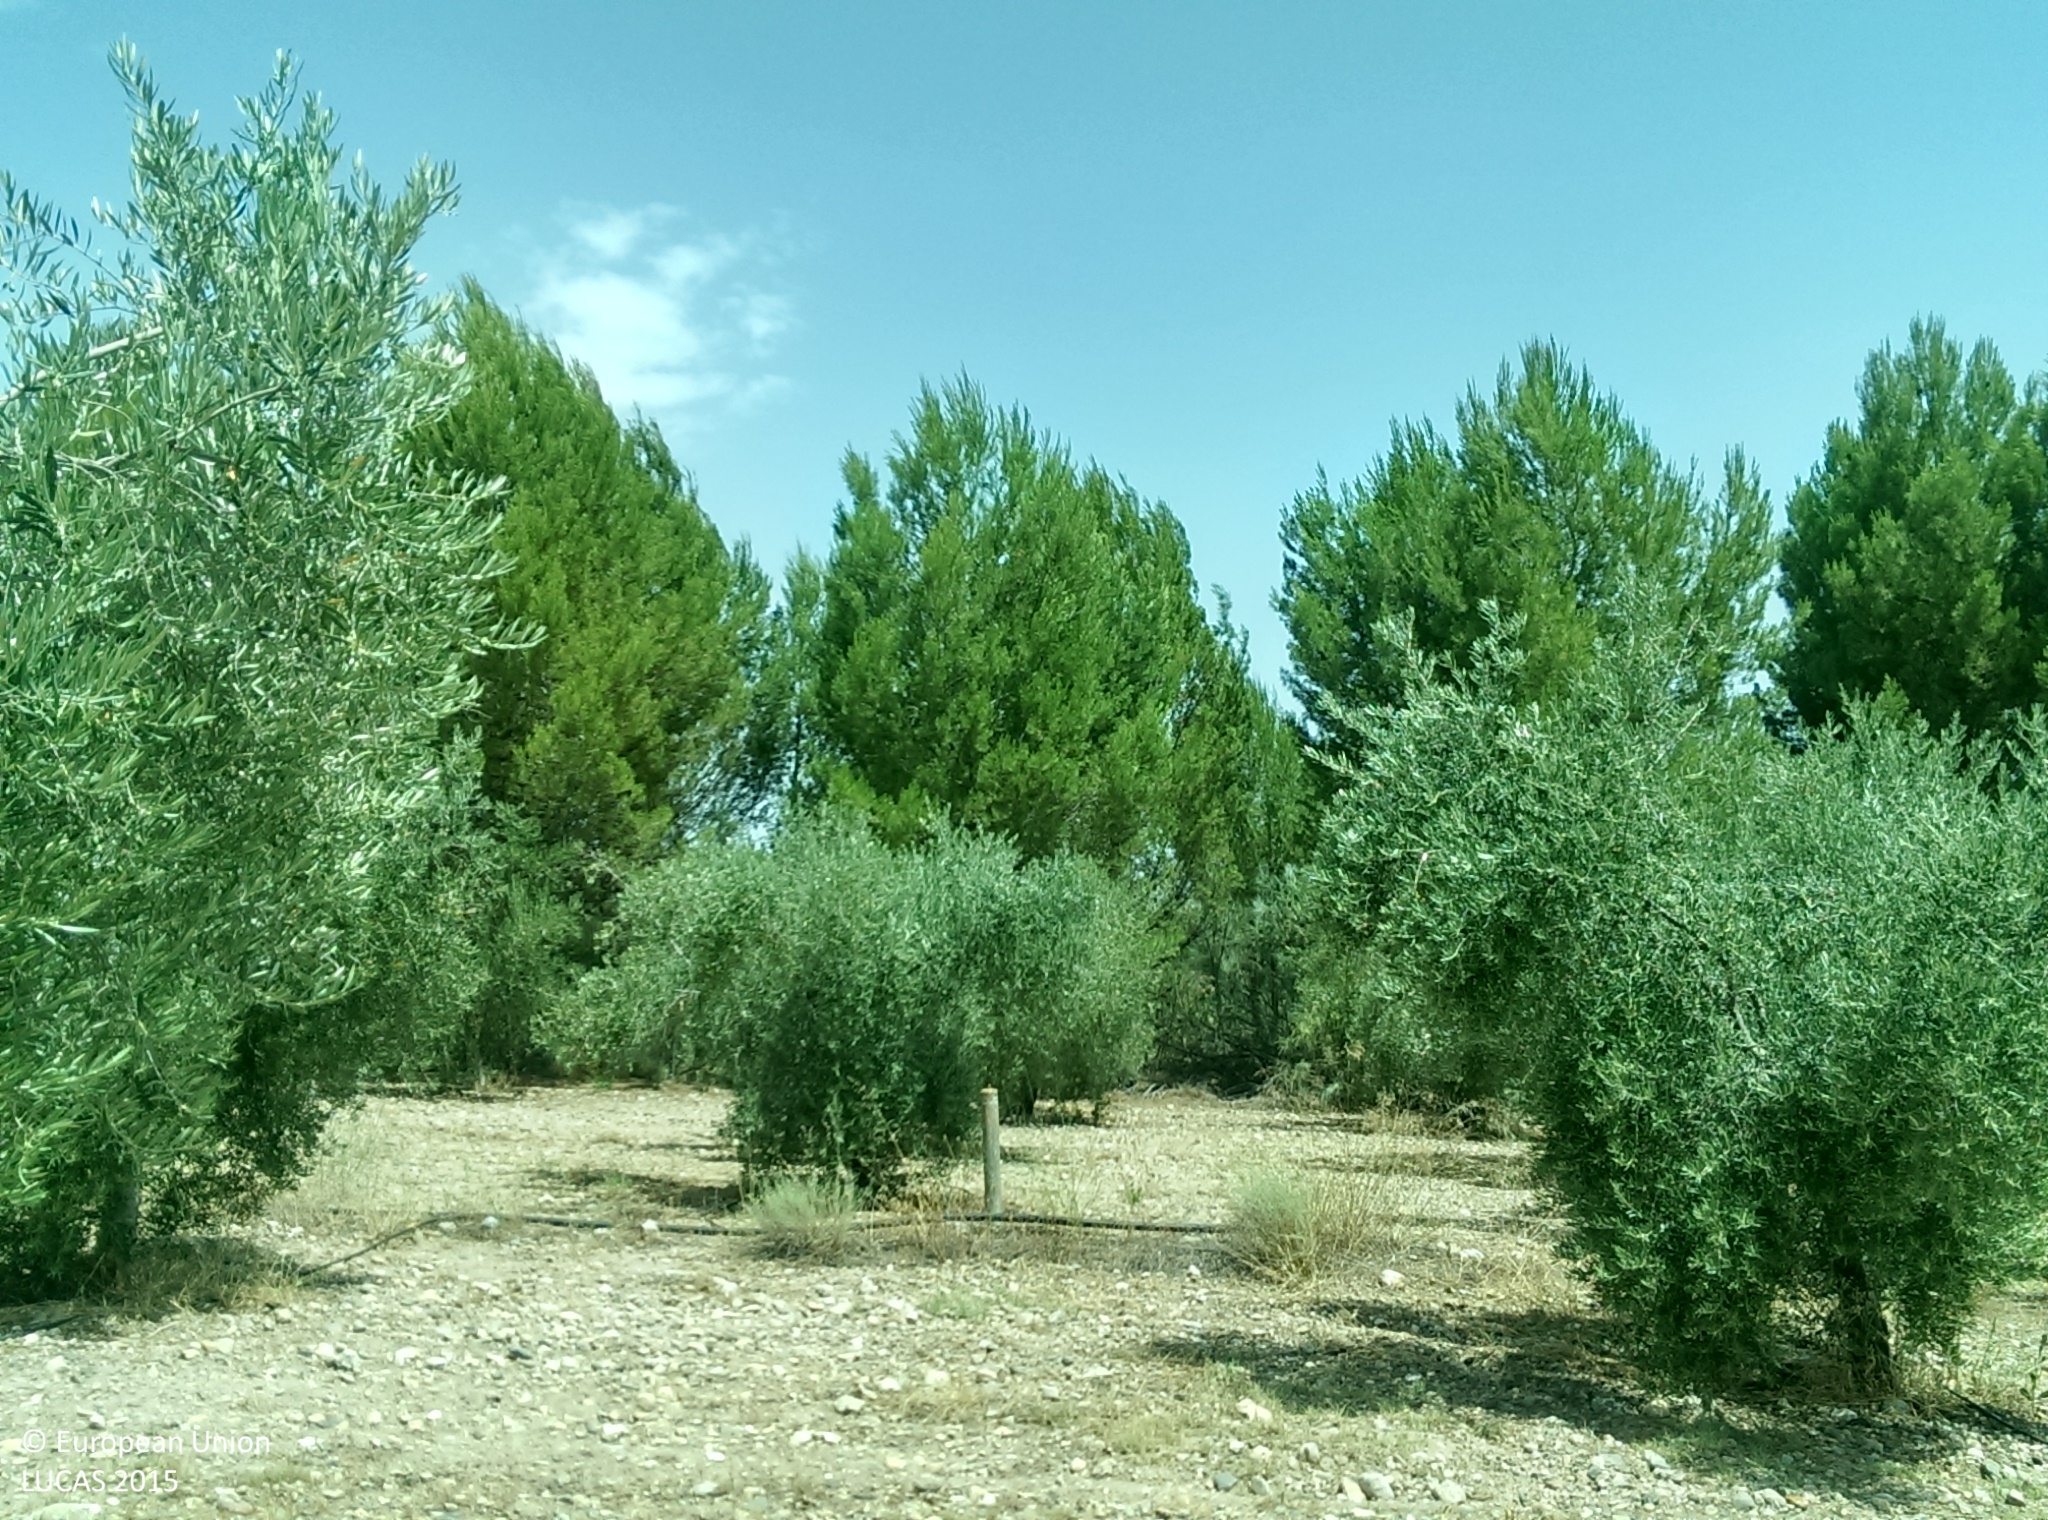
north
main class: Cropland
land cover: Olive groves
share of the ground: 25 - 50 %
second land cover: Other bare soil
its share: > 75 %
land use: Agriculture (excluding fallow land and kitchen gardens)
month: July
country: ES
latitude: 37.5161
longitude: -2.9661
